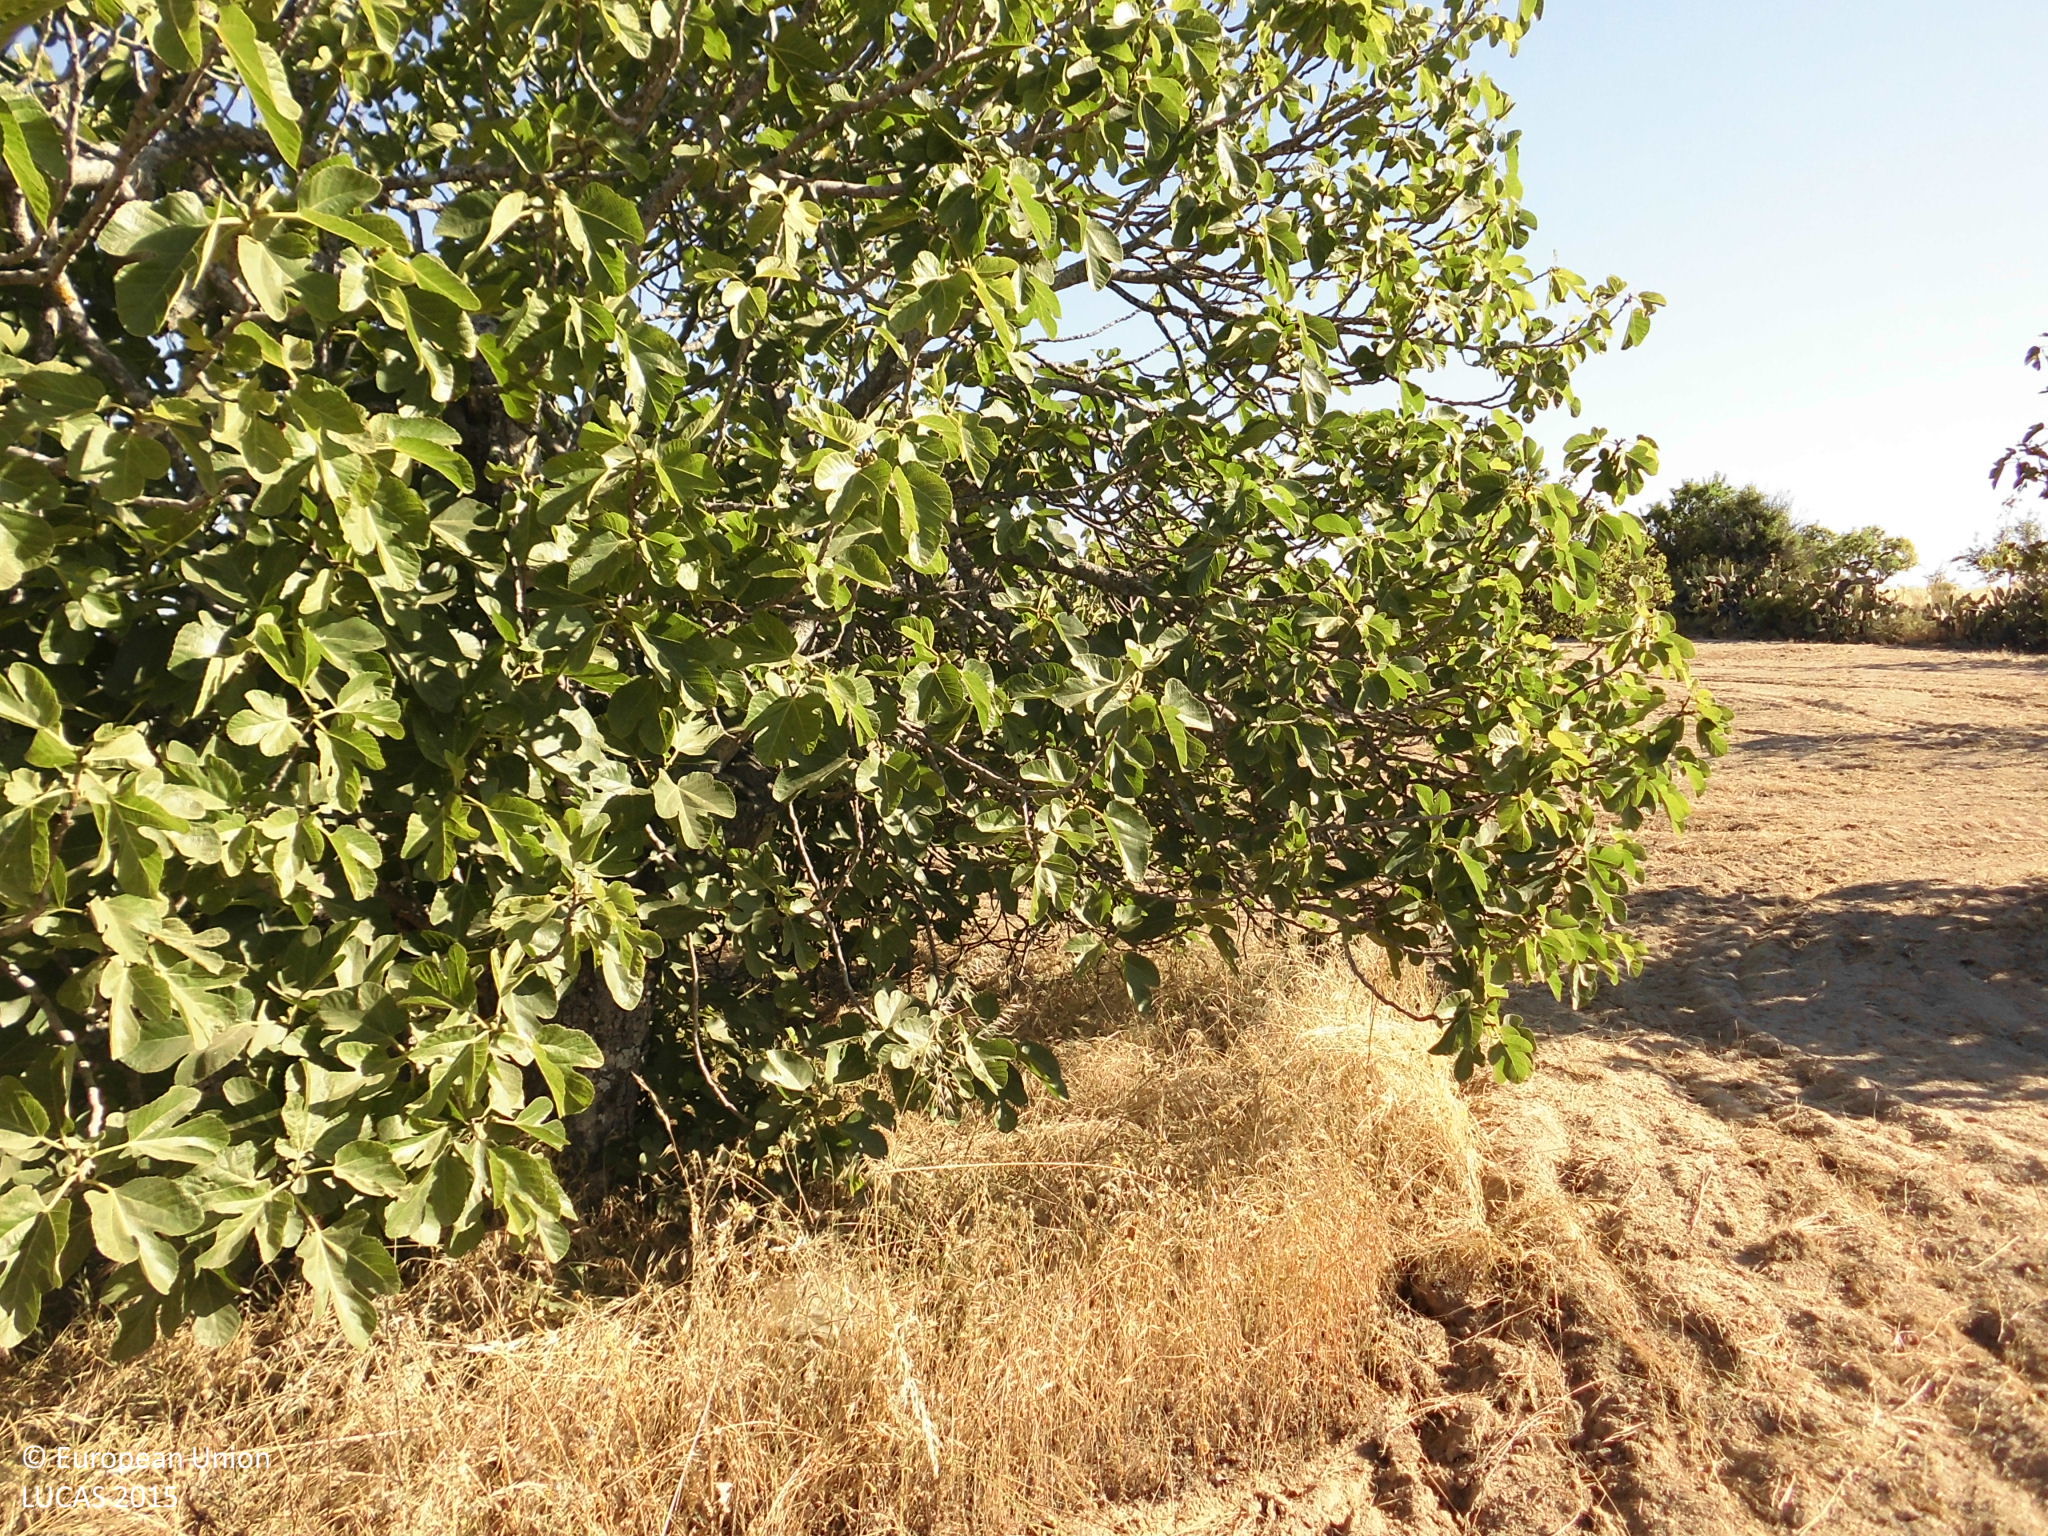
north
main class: Cropland
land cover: Other fruit trees and berries
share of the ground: 10 - 25 %
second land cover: Other bare soil
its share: > 75 %
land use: Agriculture (excluding fallow land and kitchen gardens)
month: May
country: ES
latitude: 39.8109
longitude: -6.7506
